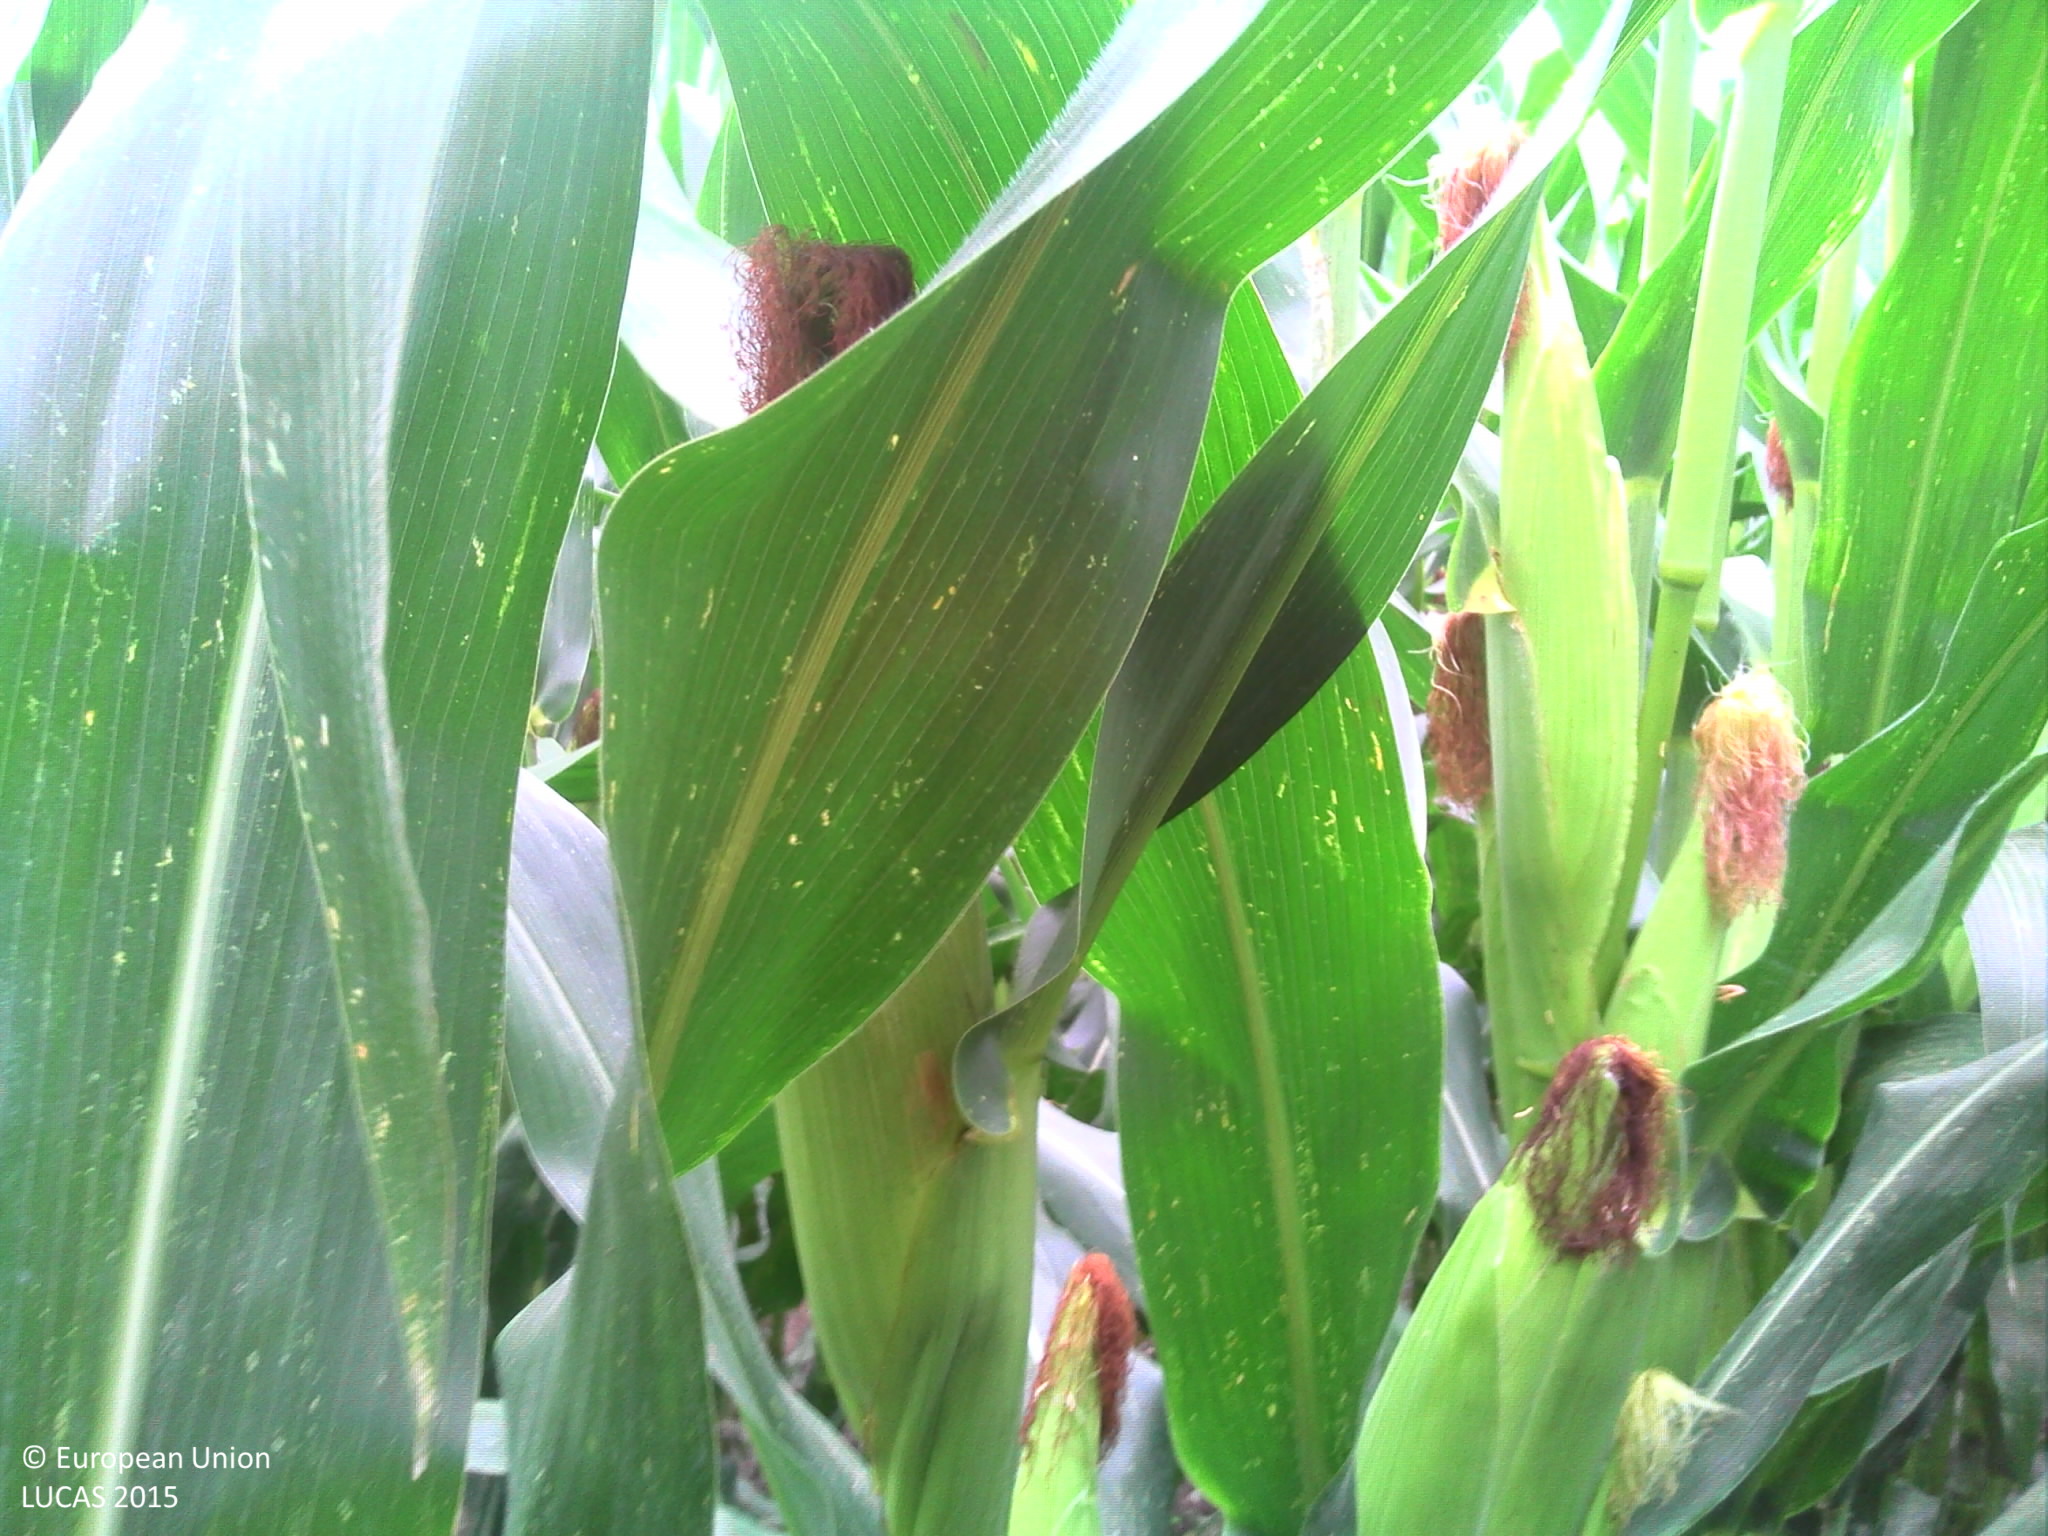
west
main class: Cropland
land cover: Maize
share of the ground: > 75 %
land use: Agriculture (excluding fallow land and kitchen gardens)
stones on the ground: 10 - 25 %
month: July
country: FR
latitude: 47.9362
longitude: 2.0502
